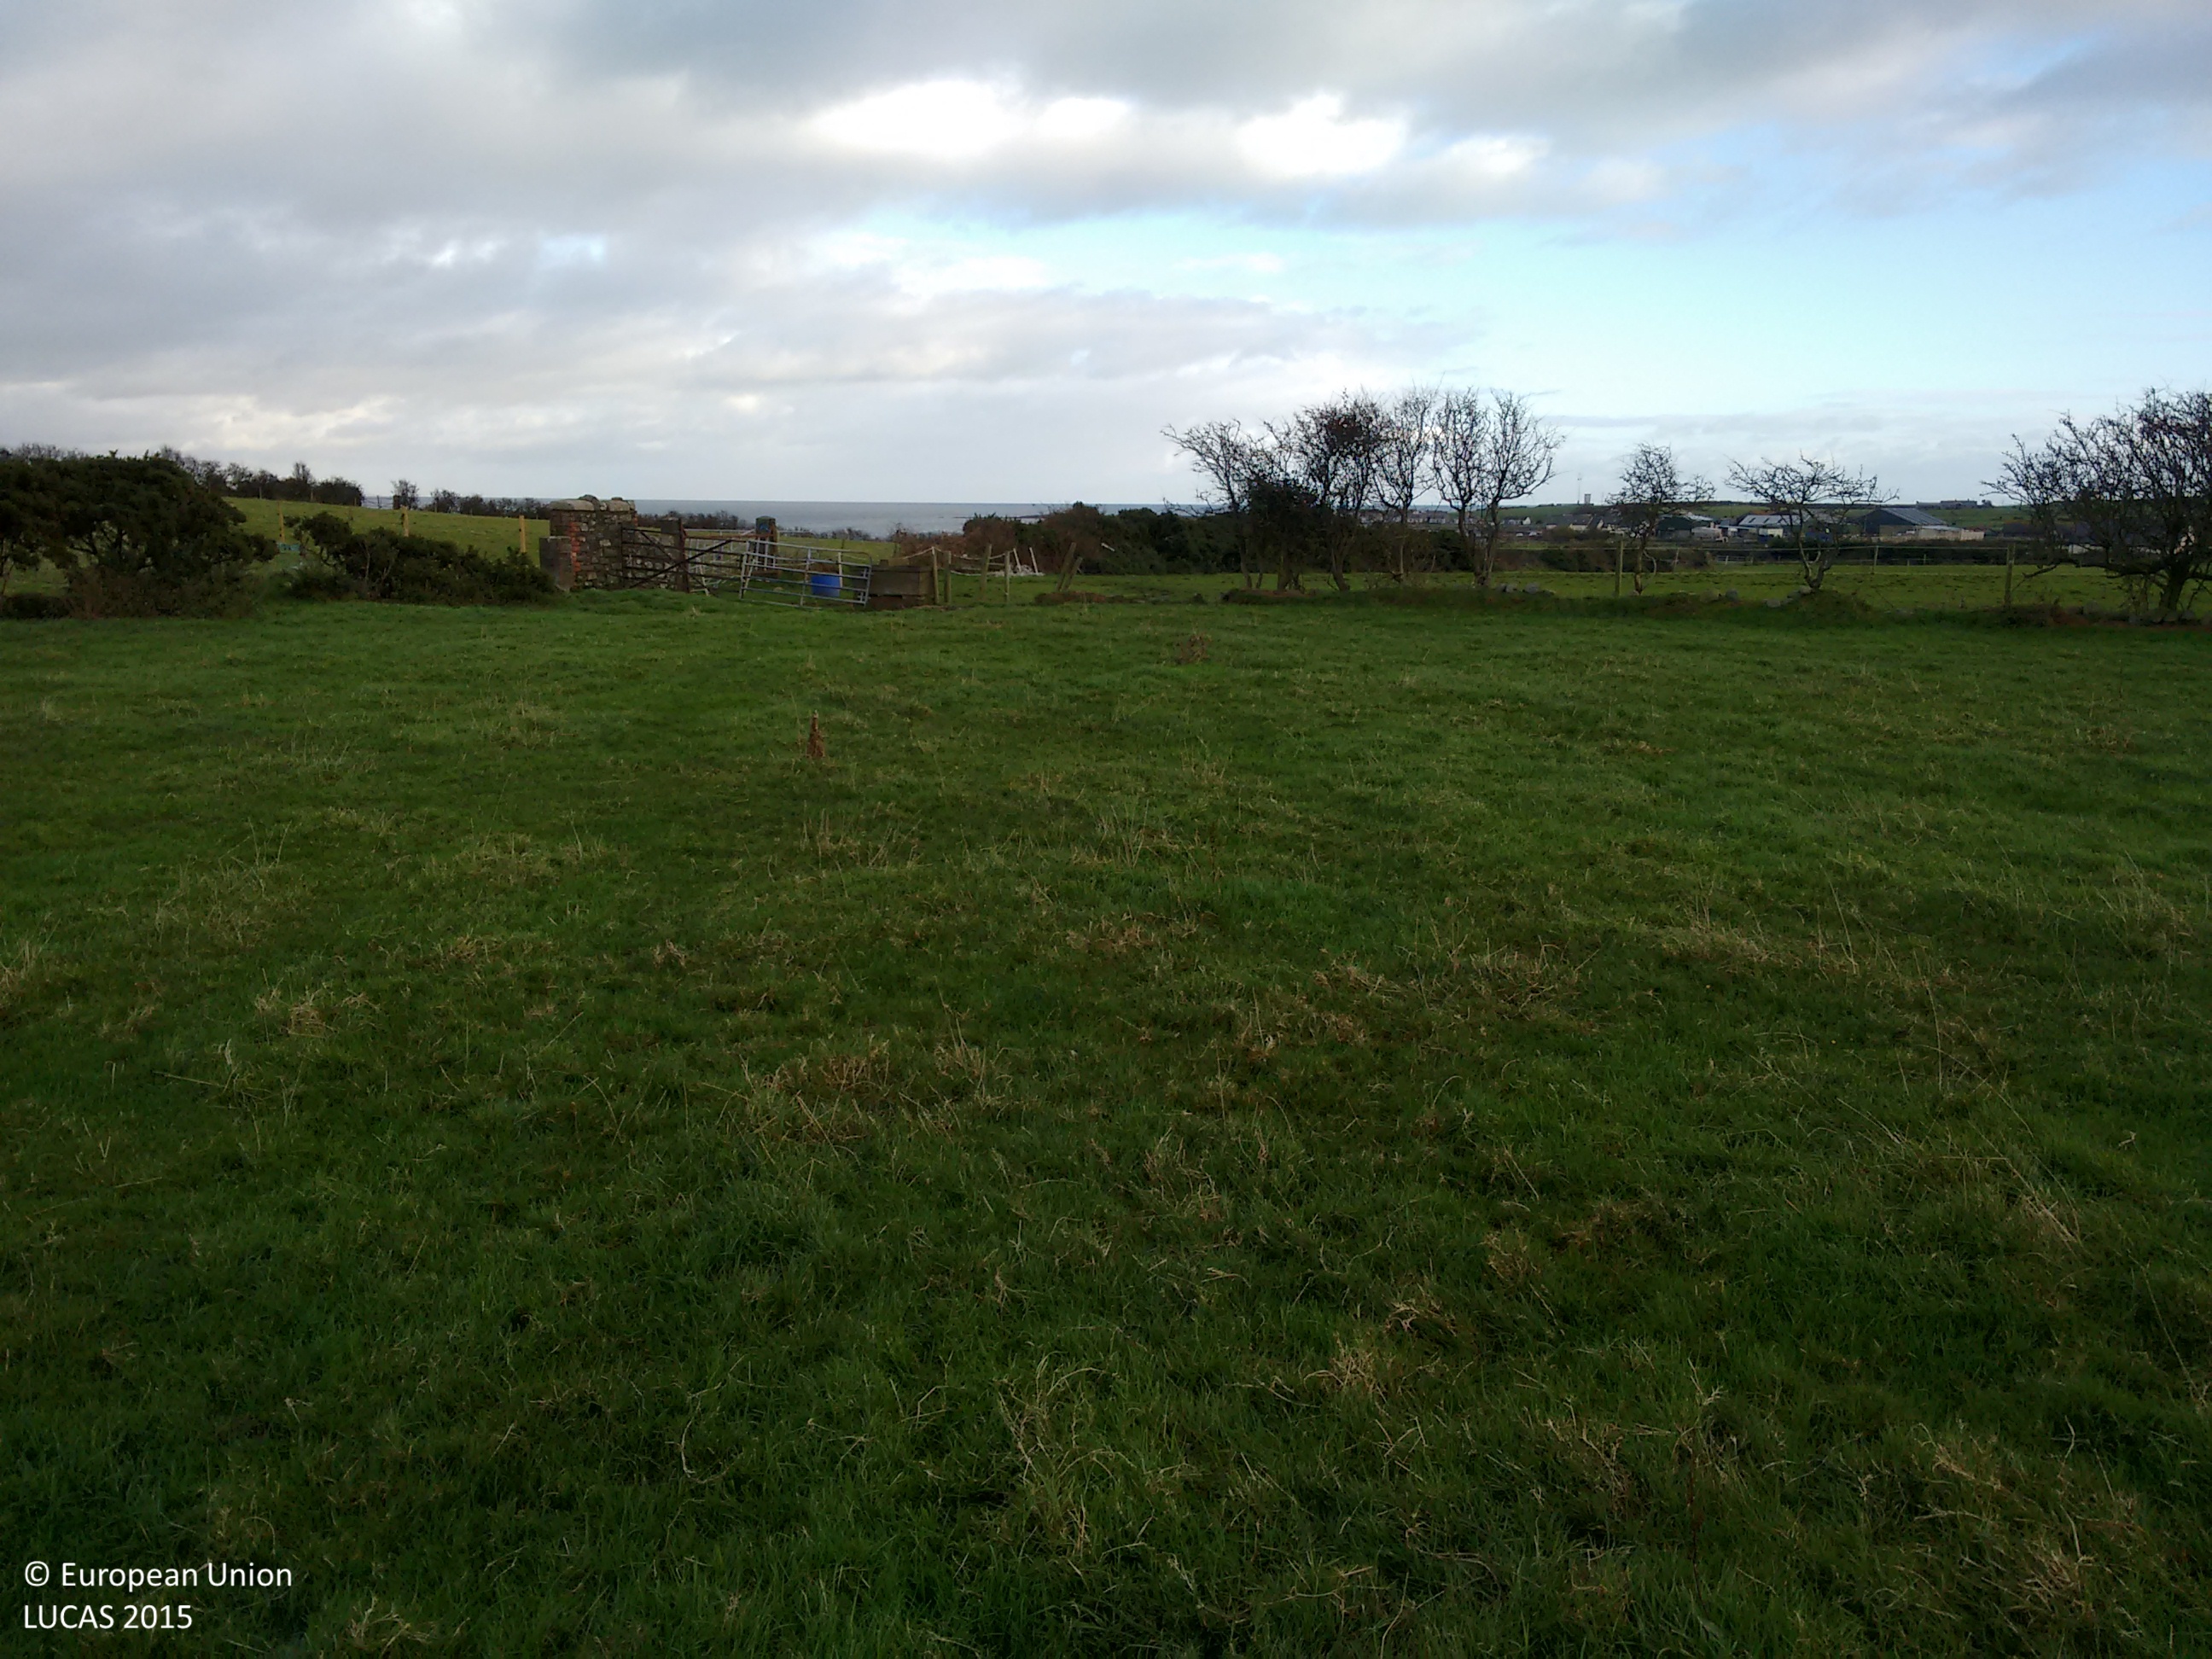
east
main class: Grassland
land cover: Grassland without tree/shrub cover
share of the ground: > 75 %
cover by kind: herbaceous plants 100 %
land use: Agriculture (excluding fallow land and kitchen gardens)
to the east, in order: Grassland without tree/shrub cover; Fences; Grassland without tree/shrub cover; Fences; Grassland without tree/shrub cover
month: November
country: GB
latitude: 54.4908
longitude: -5.4561
